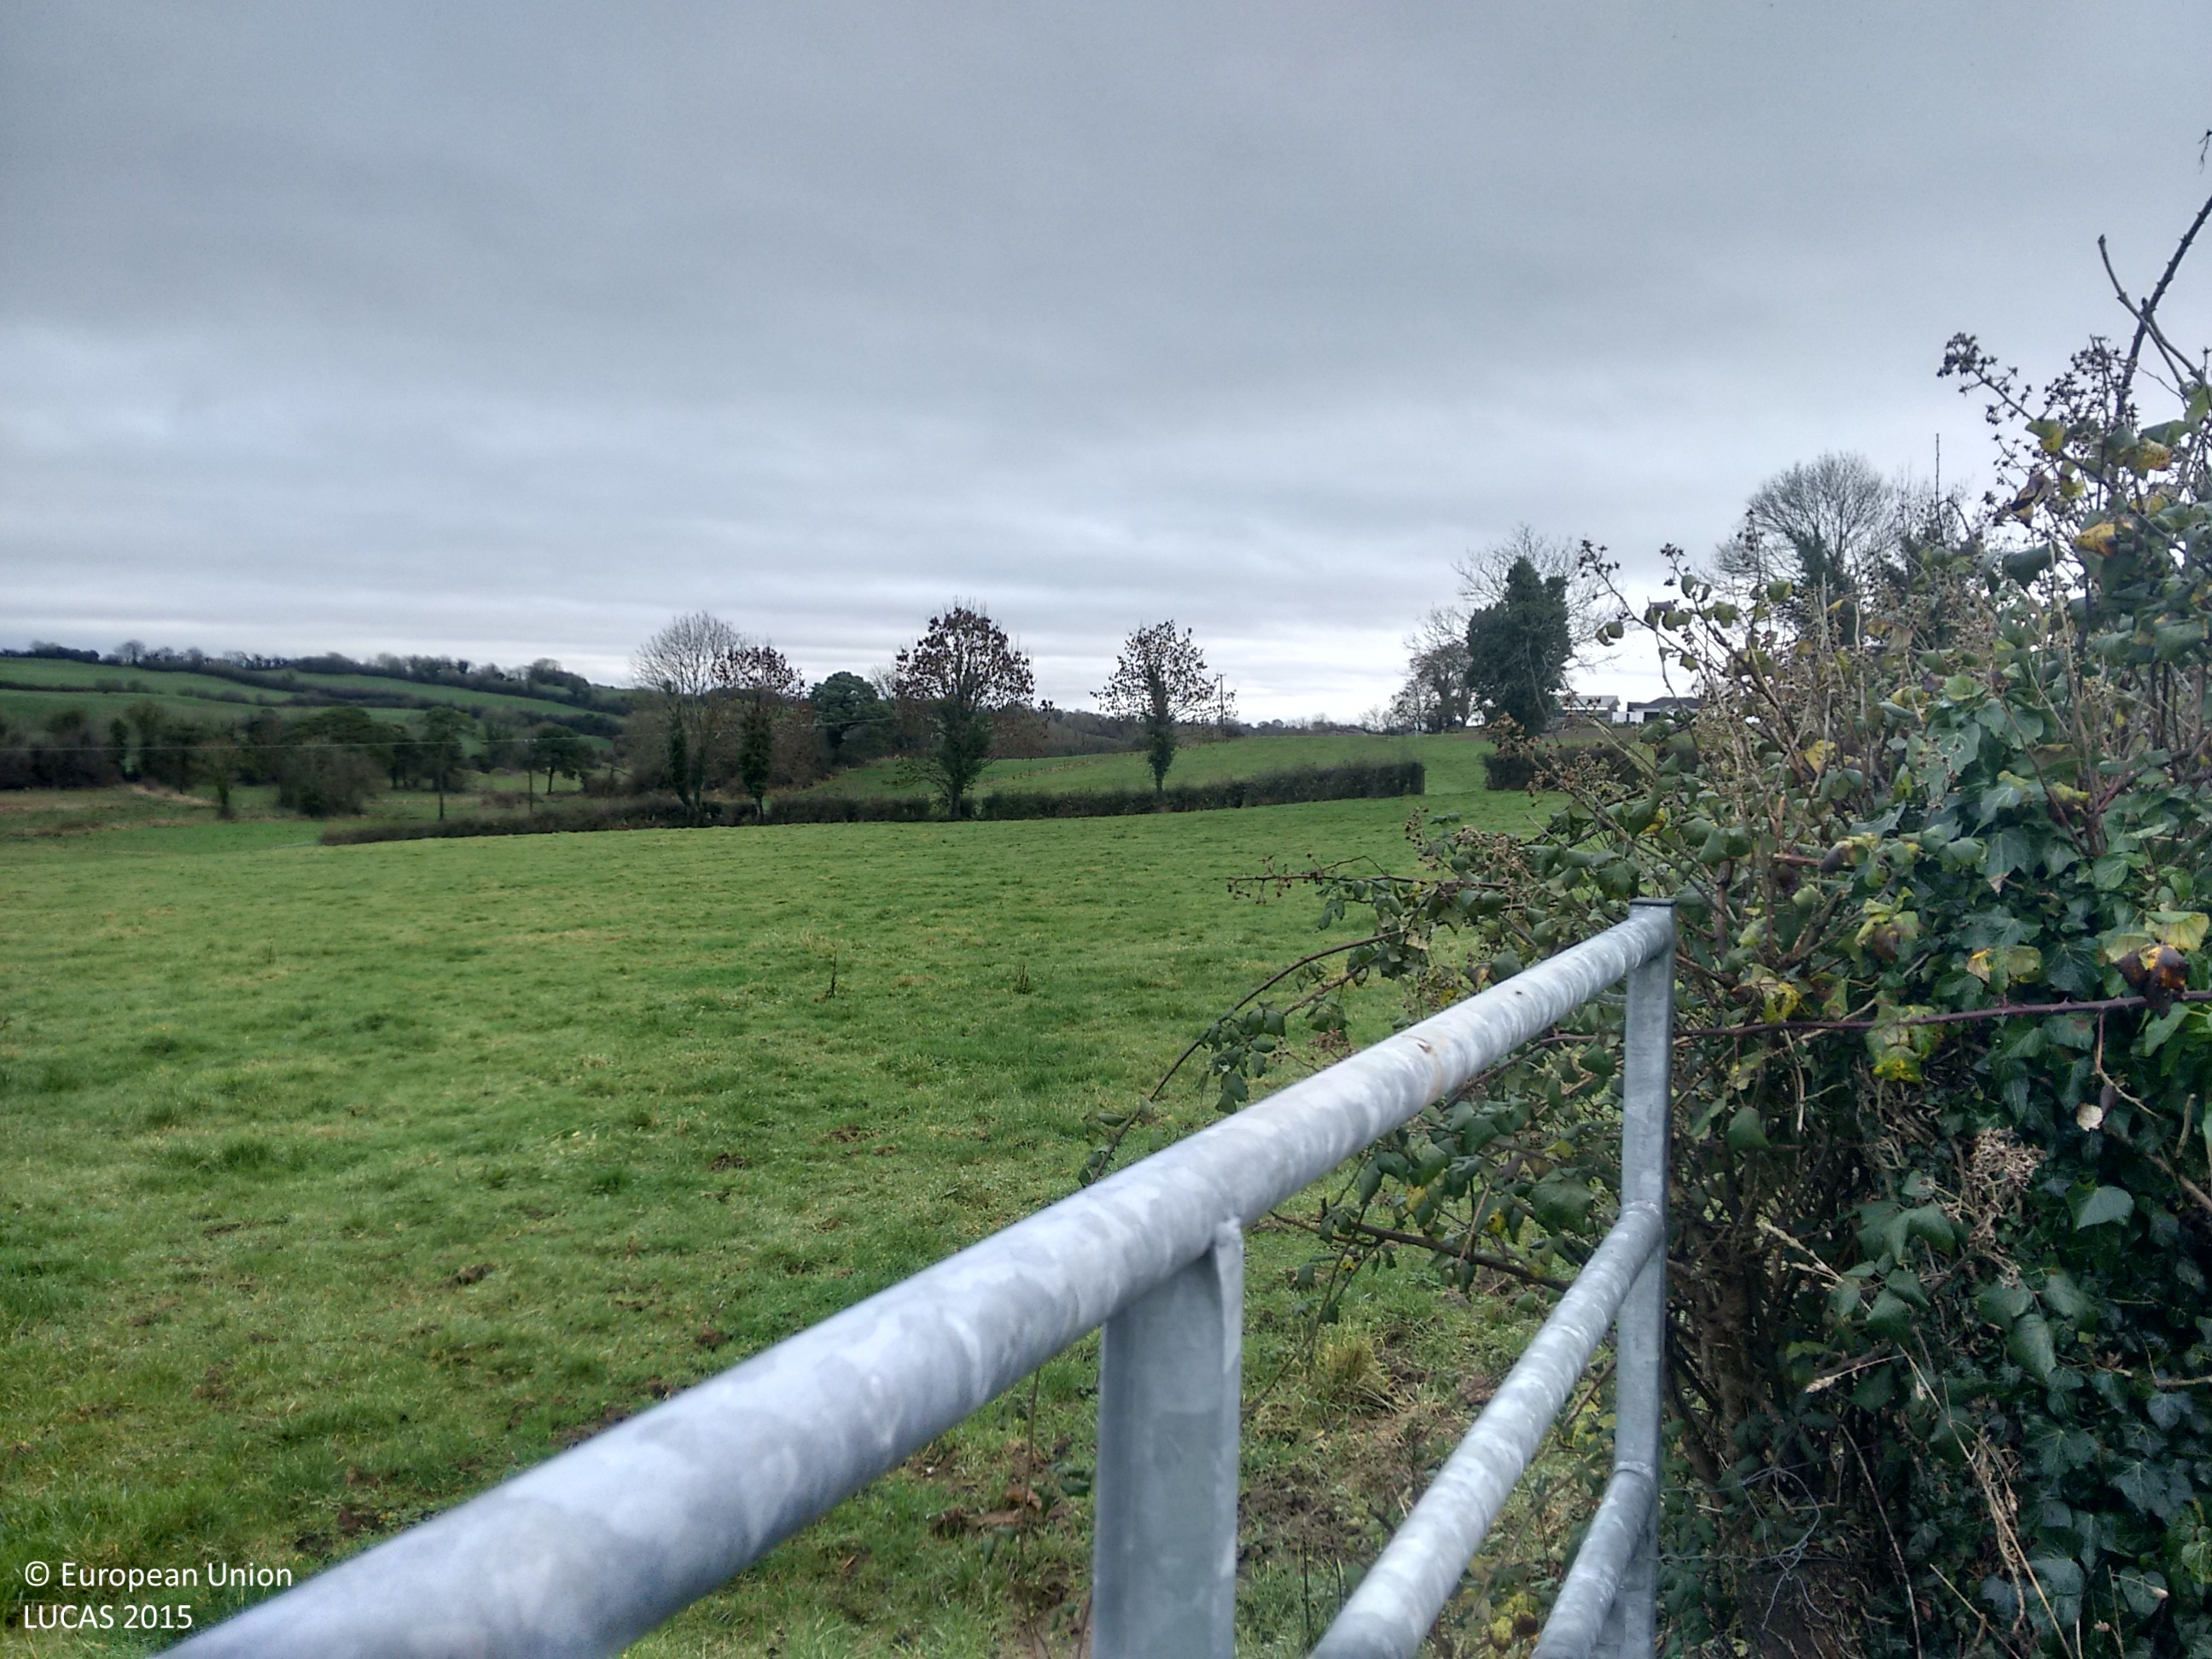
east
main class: Grassland
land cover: Grassland without tree/shrub cover
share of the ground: > 75 %
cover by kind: herbaceous plants 100 %
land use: Agriculture (excluding fallow land and kitchen gardens)
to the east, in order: Grassland without tree/shrub cover; Abandoned hedges; Grassland without tree/shrub cover
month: December
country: IE
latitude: 53.4418
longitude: -7.6103
